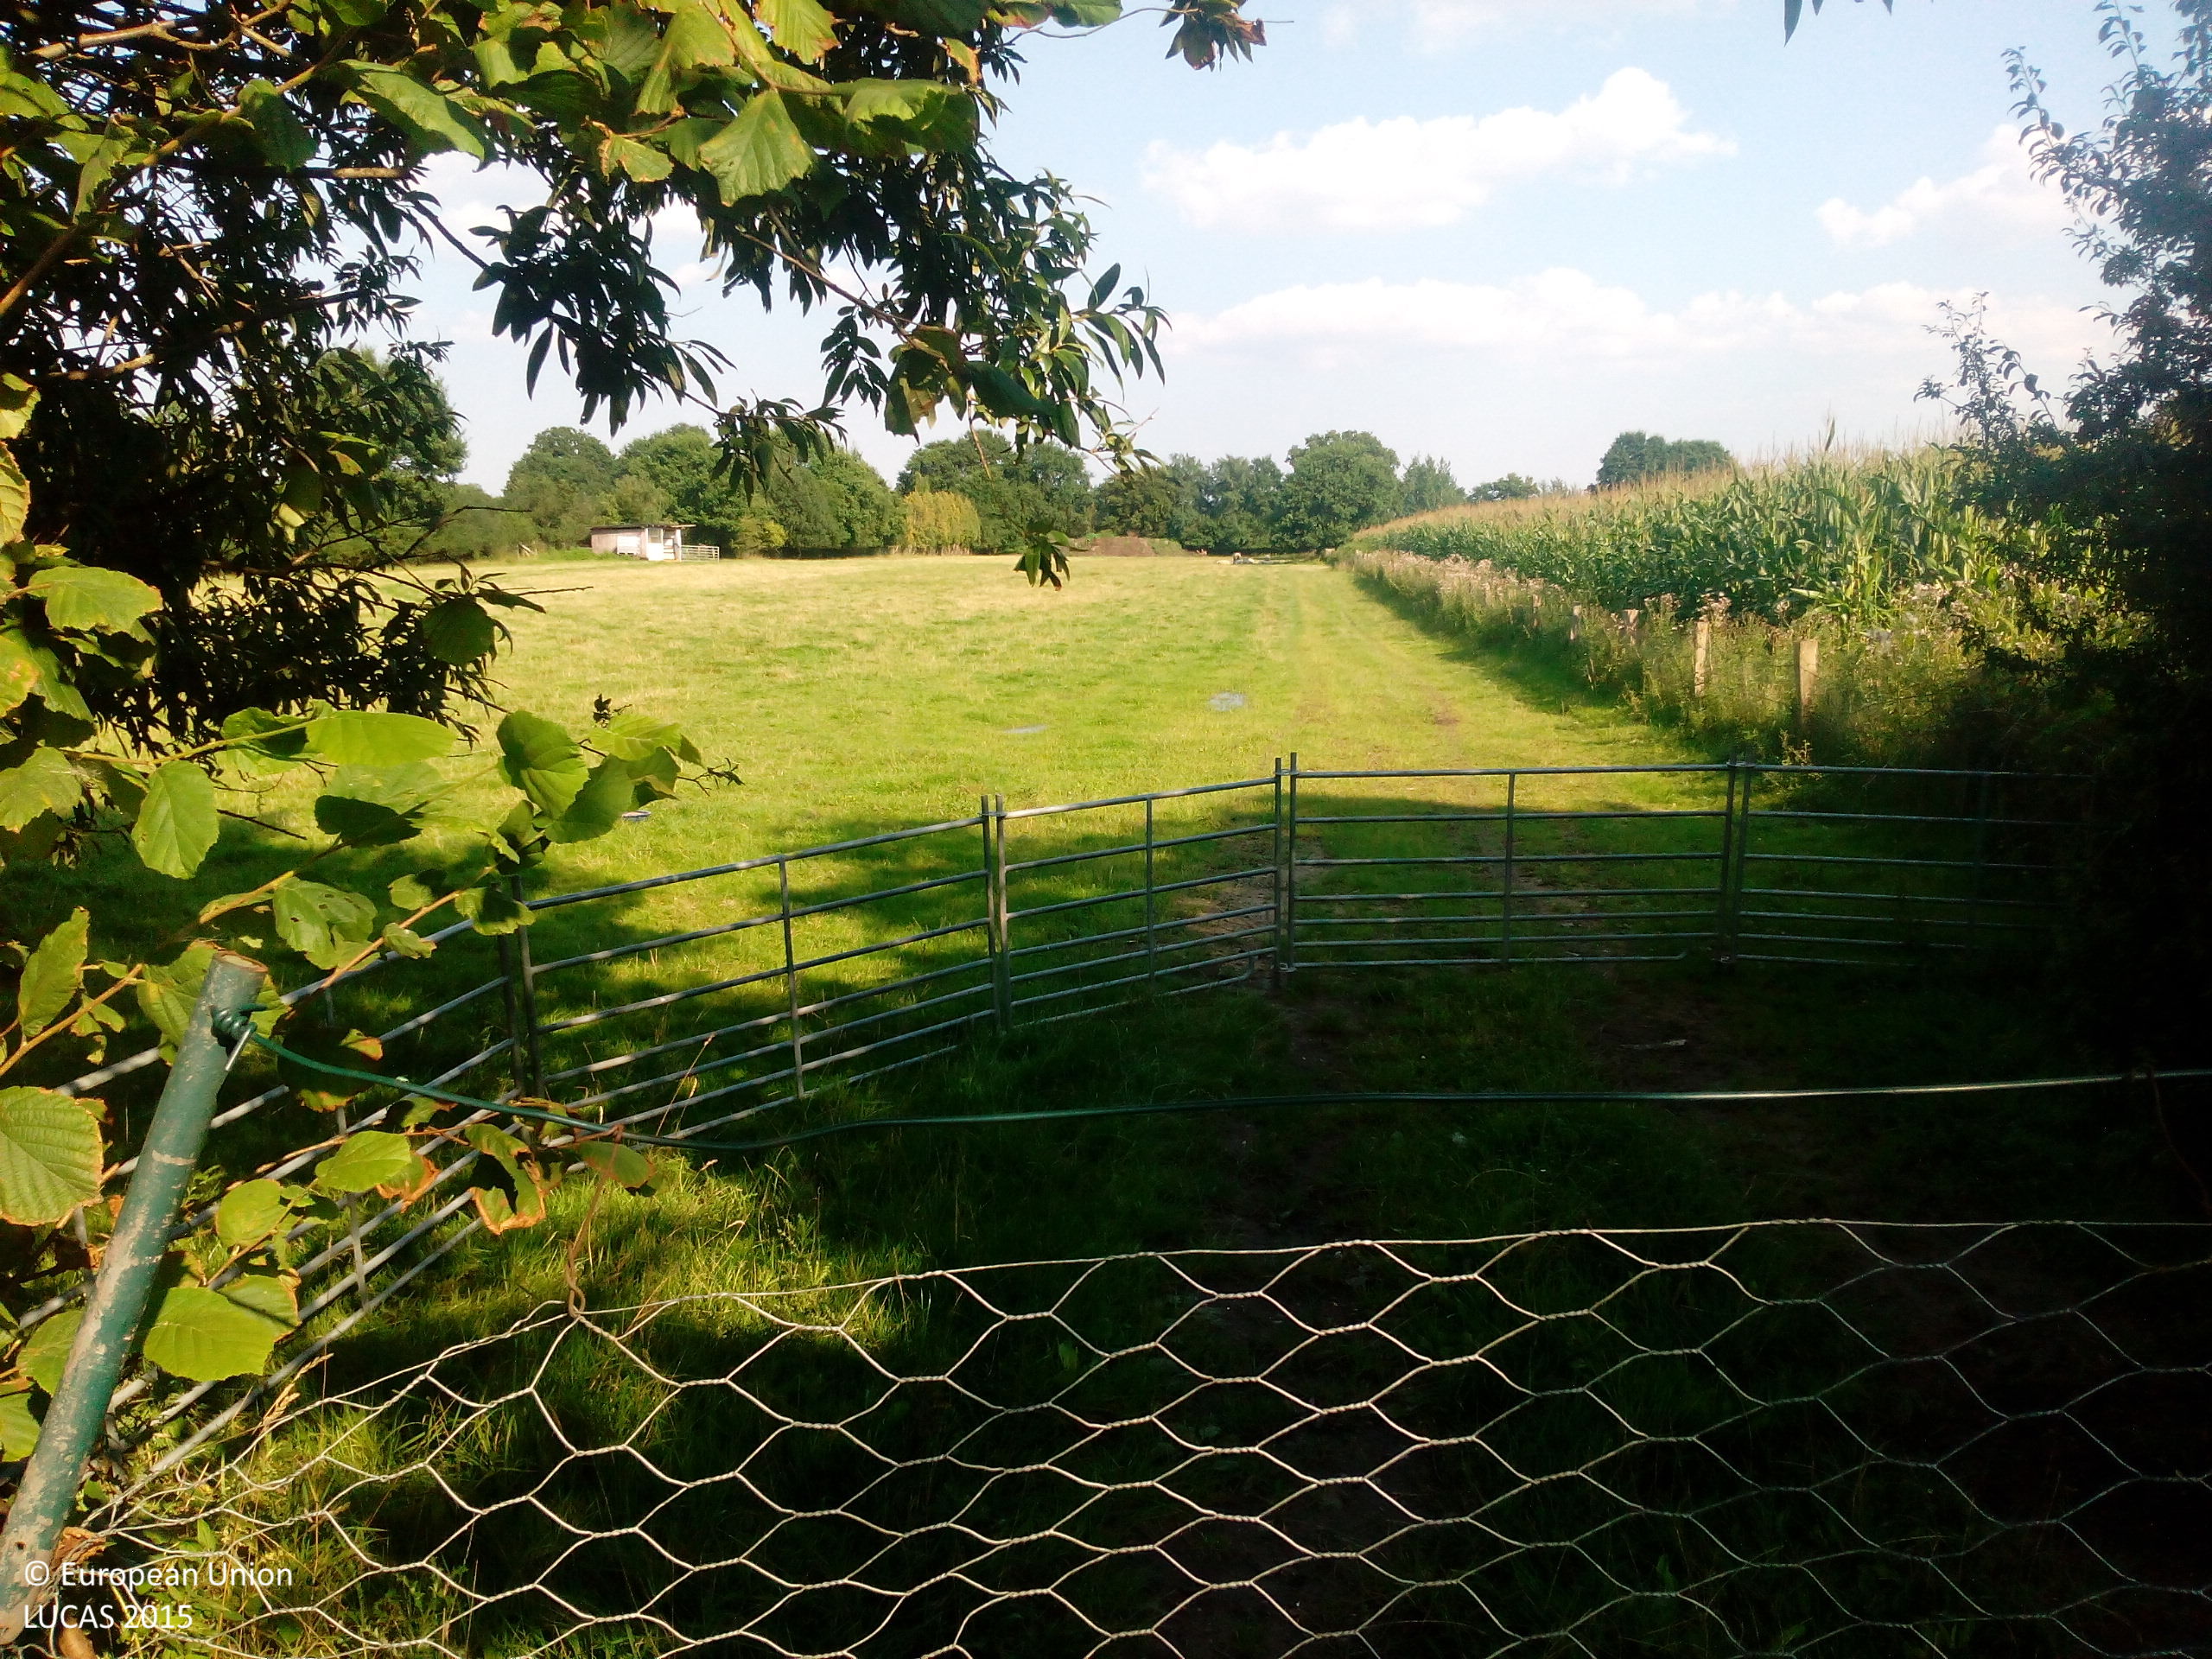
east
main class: Cropland
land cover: Maize
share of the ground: > 75 %
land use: Agriculture (excluding fallow land and kitchen gardens)
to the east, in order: Maize; Broadleaved woodland; Fences; Nurseries; Broadleaved woodland; Nurseries; Fences; Broadleaved woodland; Ditches and canals; Paved roads, cycling and walking lanes; Ditches and canals; Managed hedges; Common wheat
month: August
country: DE
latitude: 53.6894
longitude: 9.8638
